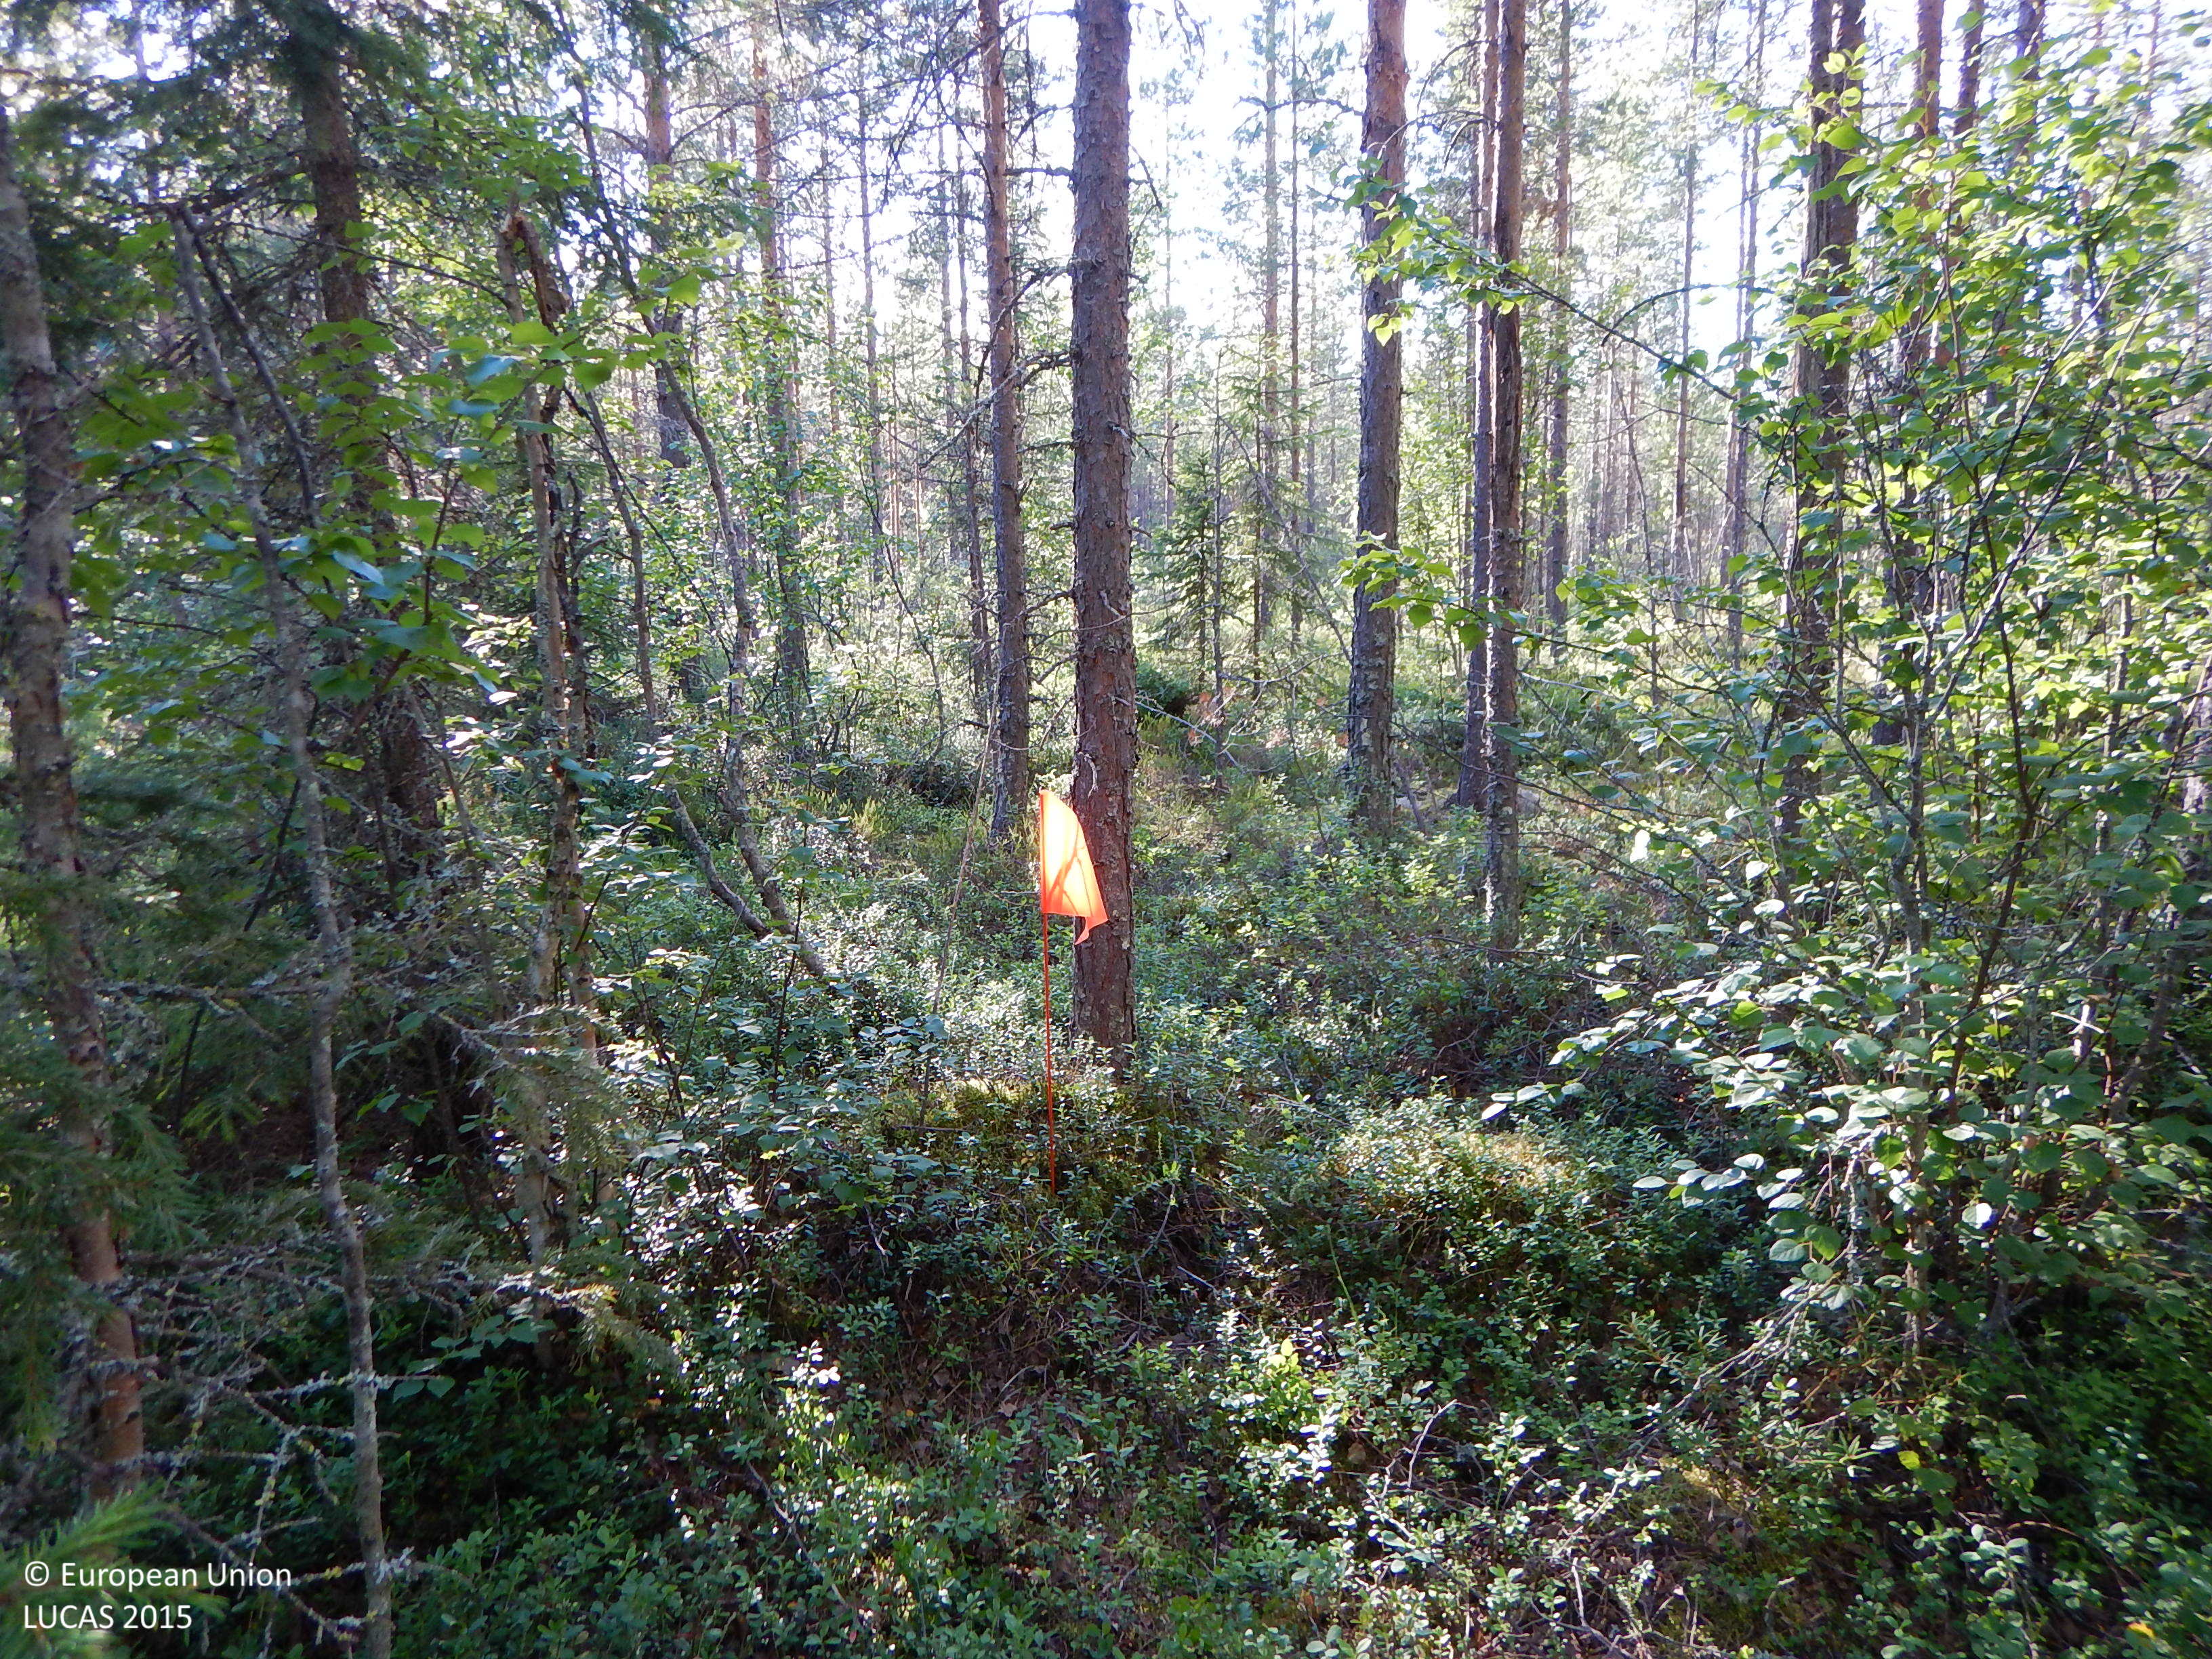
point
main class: Woodland
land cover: Pine dominated coniferous woodland
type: boreal forest
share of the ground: 50 - 75 %
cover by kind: coniferous forest trees 50 %, herbaceous plants 15 %, lichens and mosses 15 %, broadleaved forest trees 10 %, shrubs 10 %
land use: Forestry
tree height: > 5 m
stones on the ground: < 10 %
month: July
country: SE
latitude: 64.7865
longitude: 20.9388
